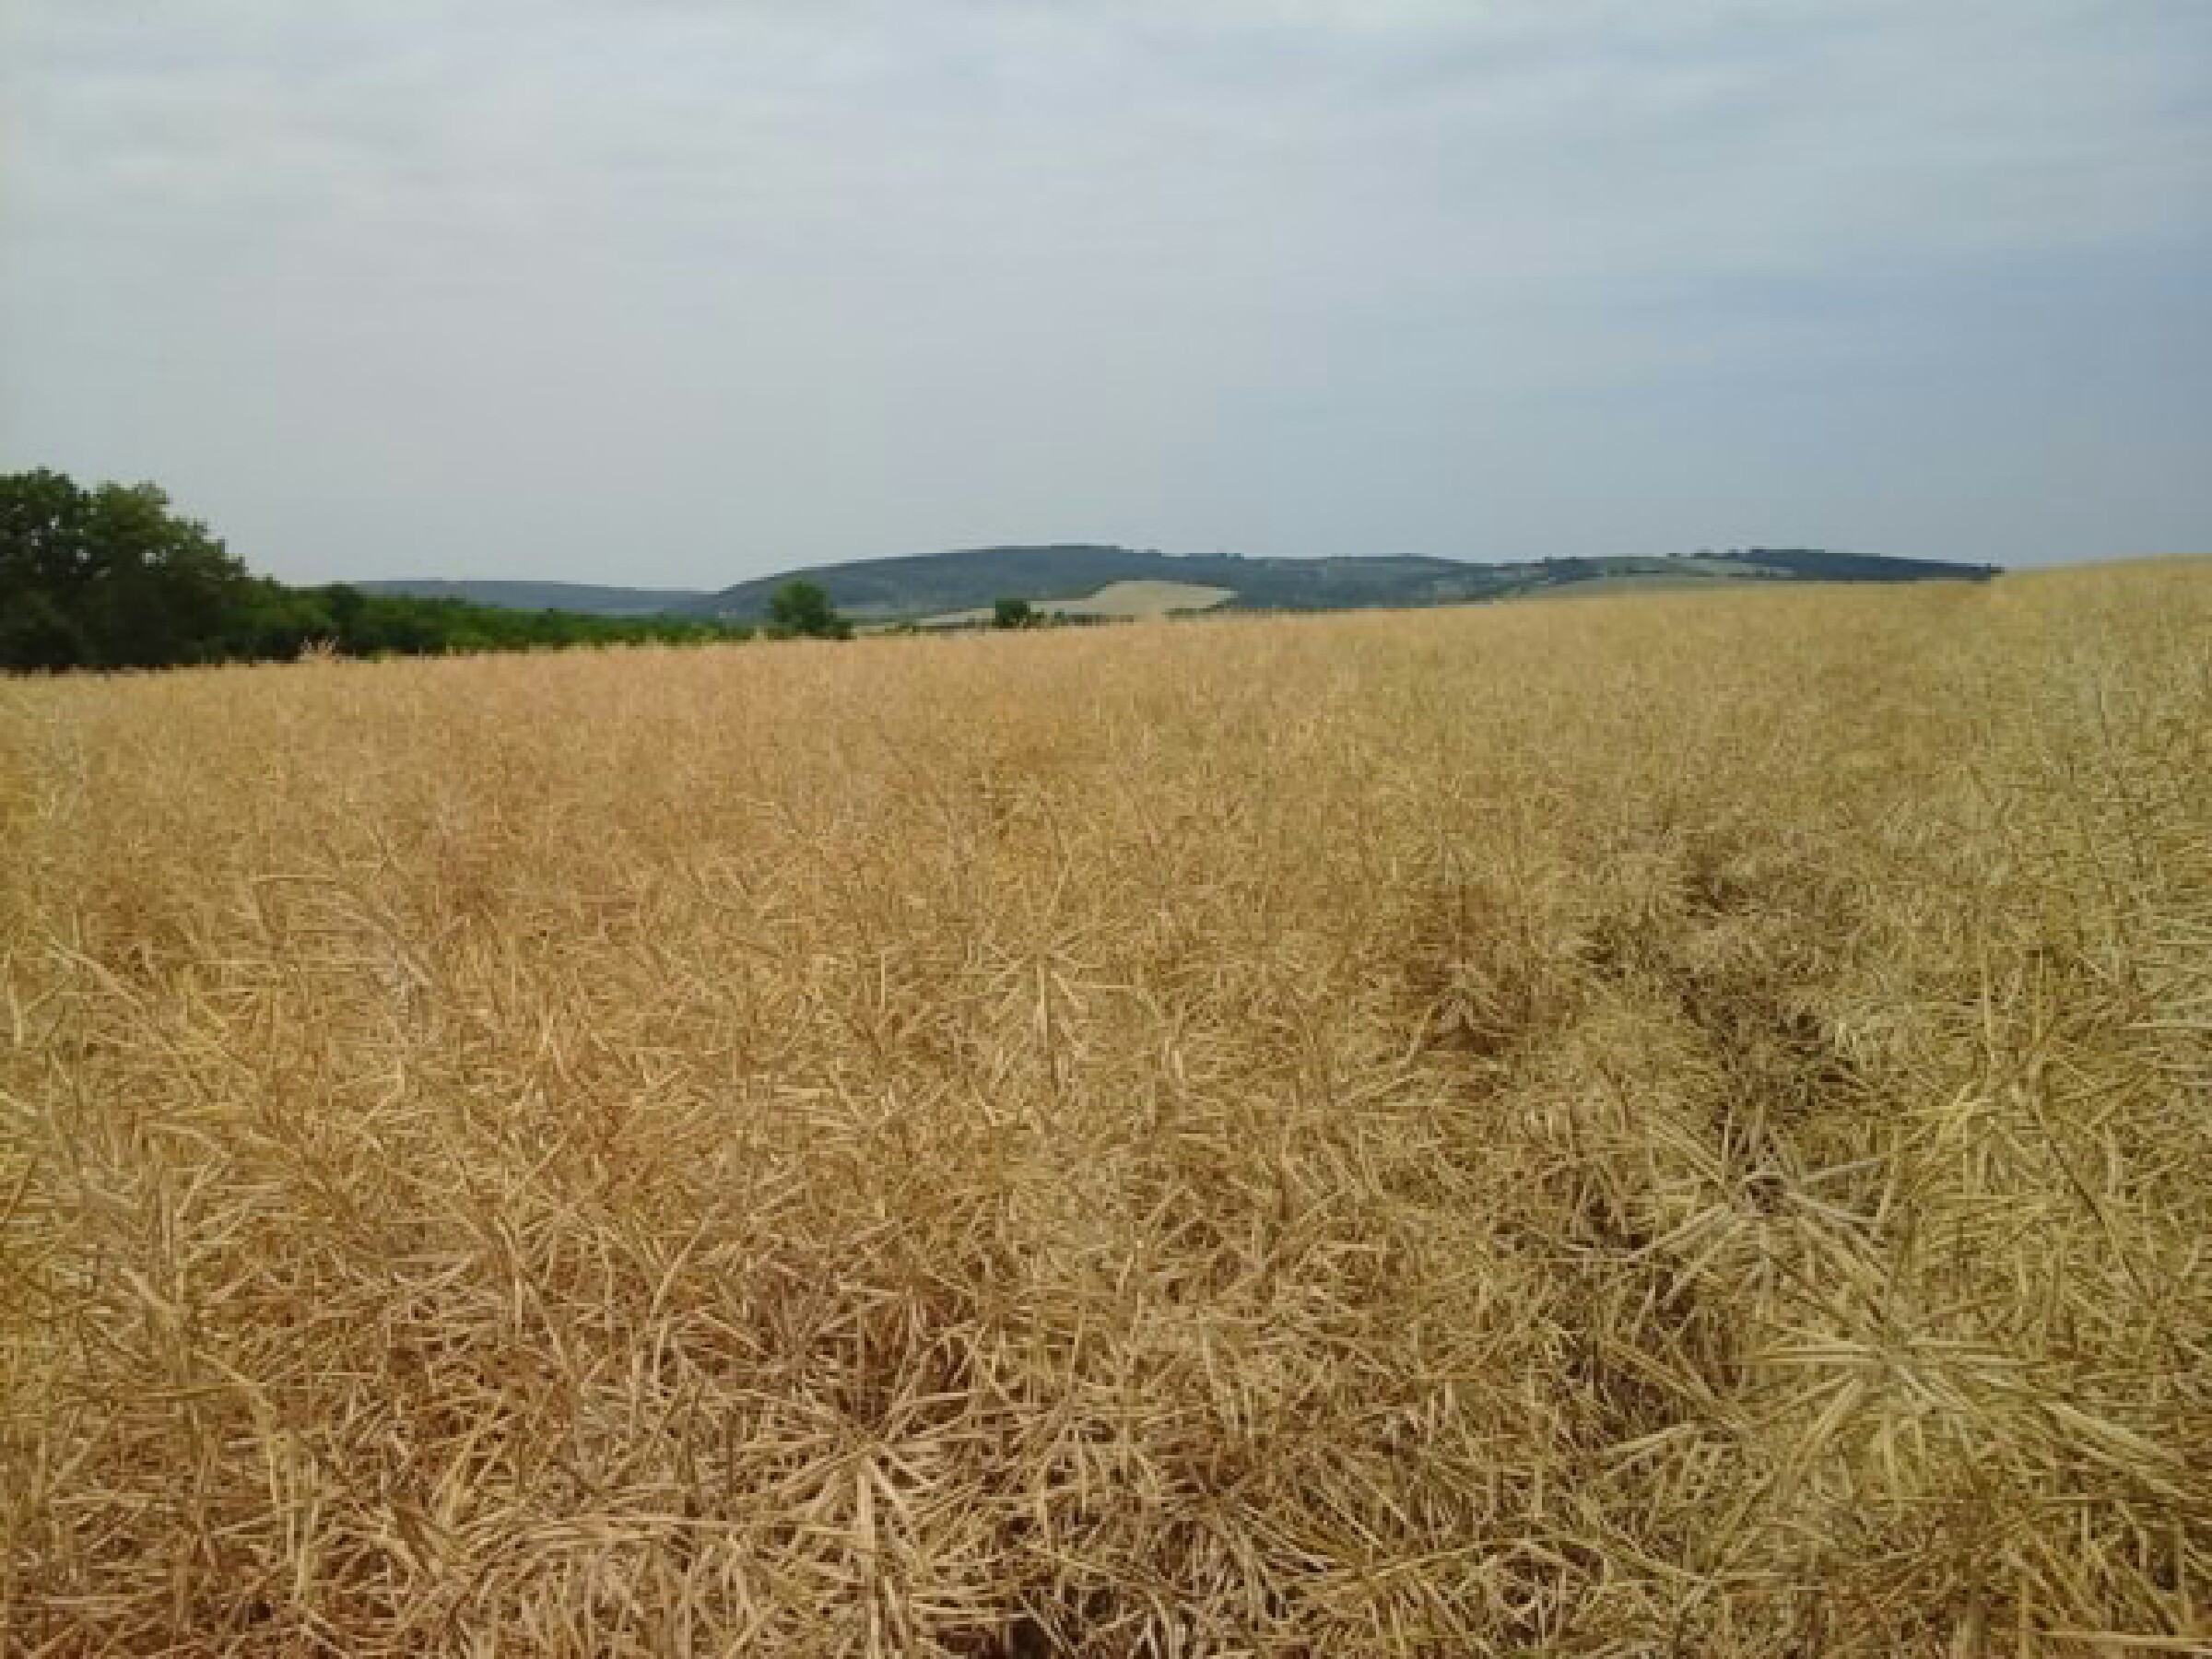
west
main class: Cropland
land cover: Rape and turnip rape
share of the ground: > 75 %
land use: Agriculture (excluding fallow land and kitchen gardens)
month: July
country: HU
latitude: 47.8493
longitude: 19.2821
